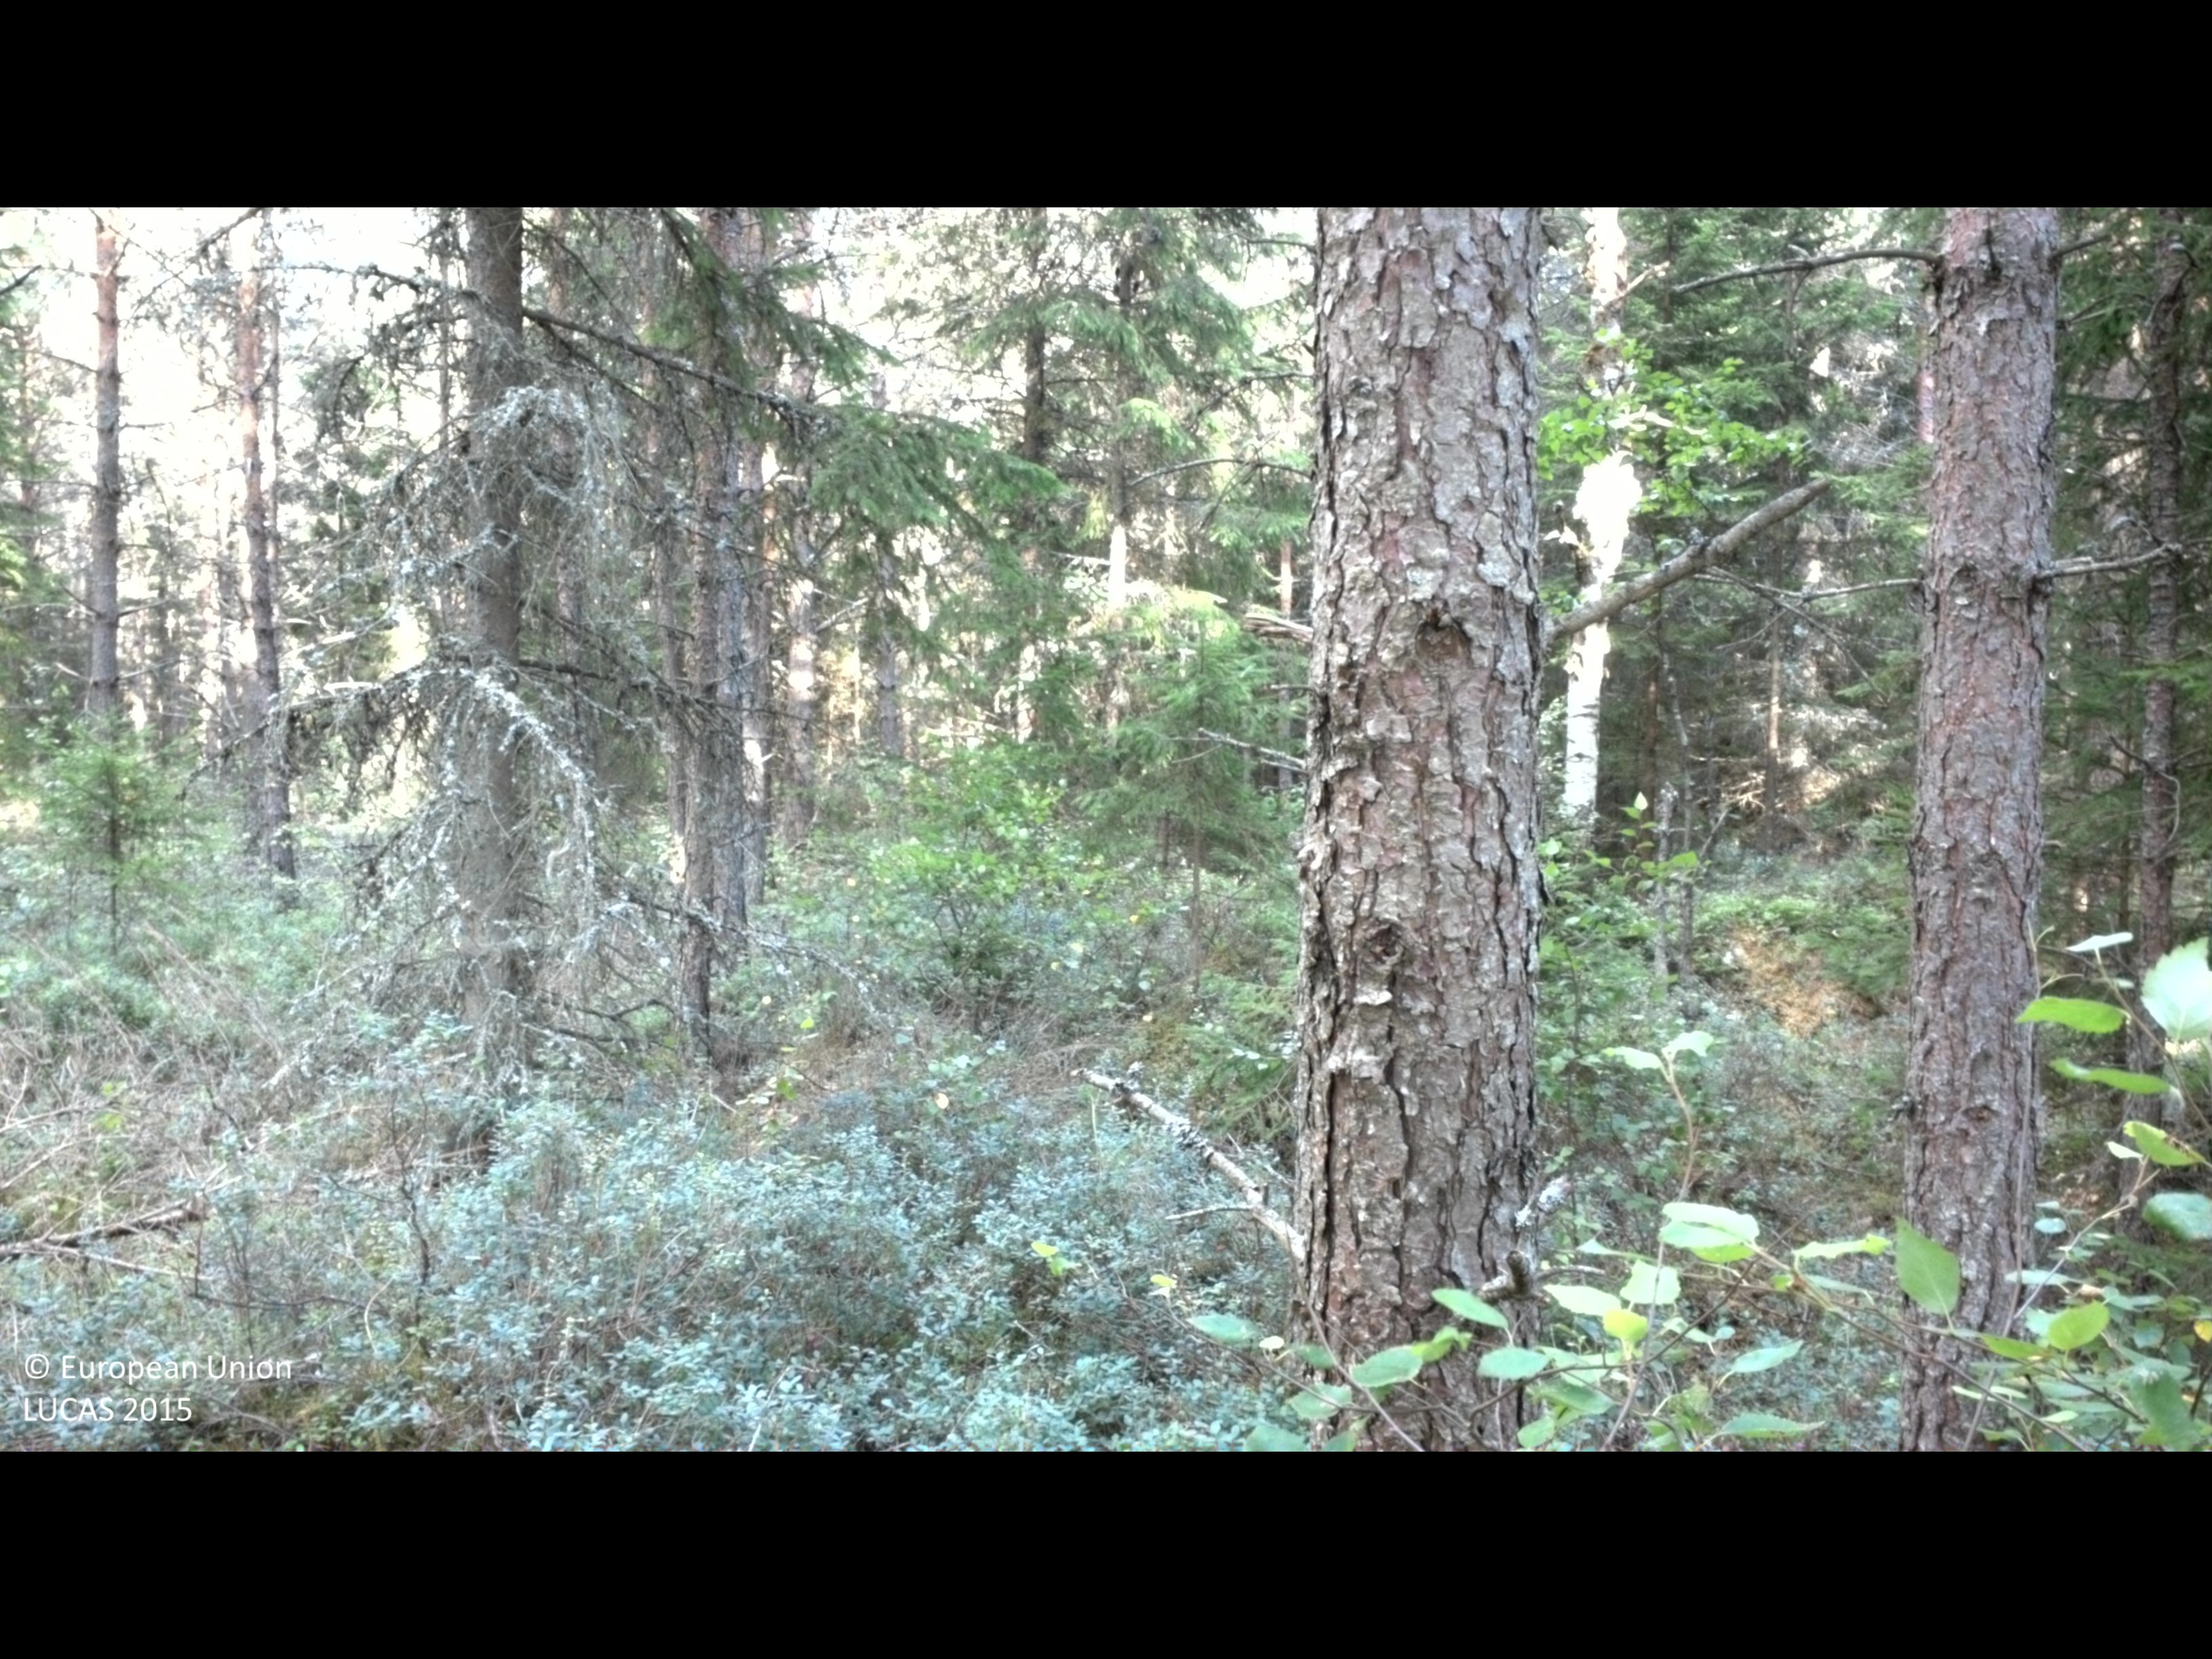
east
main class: Woodland
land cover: Pine dominated coniferous woodland
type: boreal forest
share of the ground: > 75 %
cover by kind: coniferous forest trees 75 %, shrubs 25 %
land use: Forestry
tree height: > 5 m
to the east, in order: Pine dominated coniferous woodland; Spruce dominated coniferous woodland; Ditches and canals; Pine dominated coniferous woodland; Ditches and canals; Spruce dominated coniferous woodland; Shrubland with sparse tree cover; Spruce dominated mixed woodland; Spruce dominated coniferous woodland
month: August
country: SE
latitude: 57.2270
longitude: 13.8884
